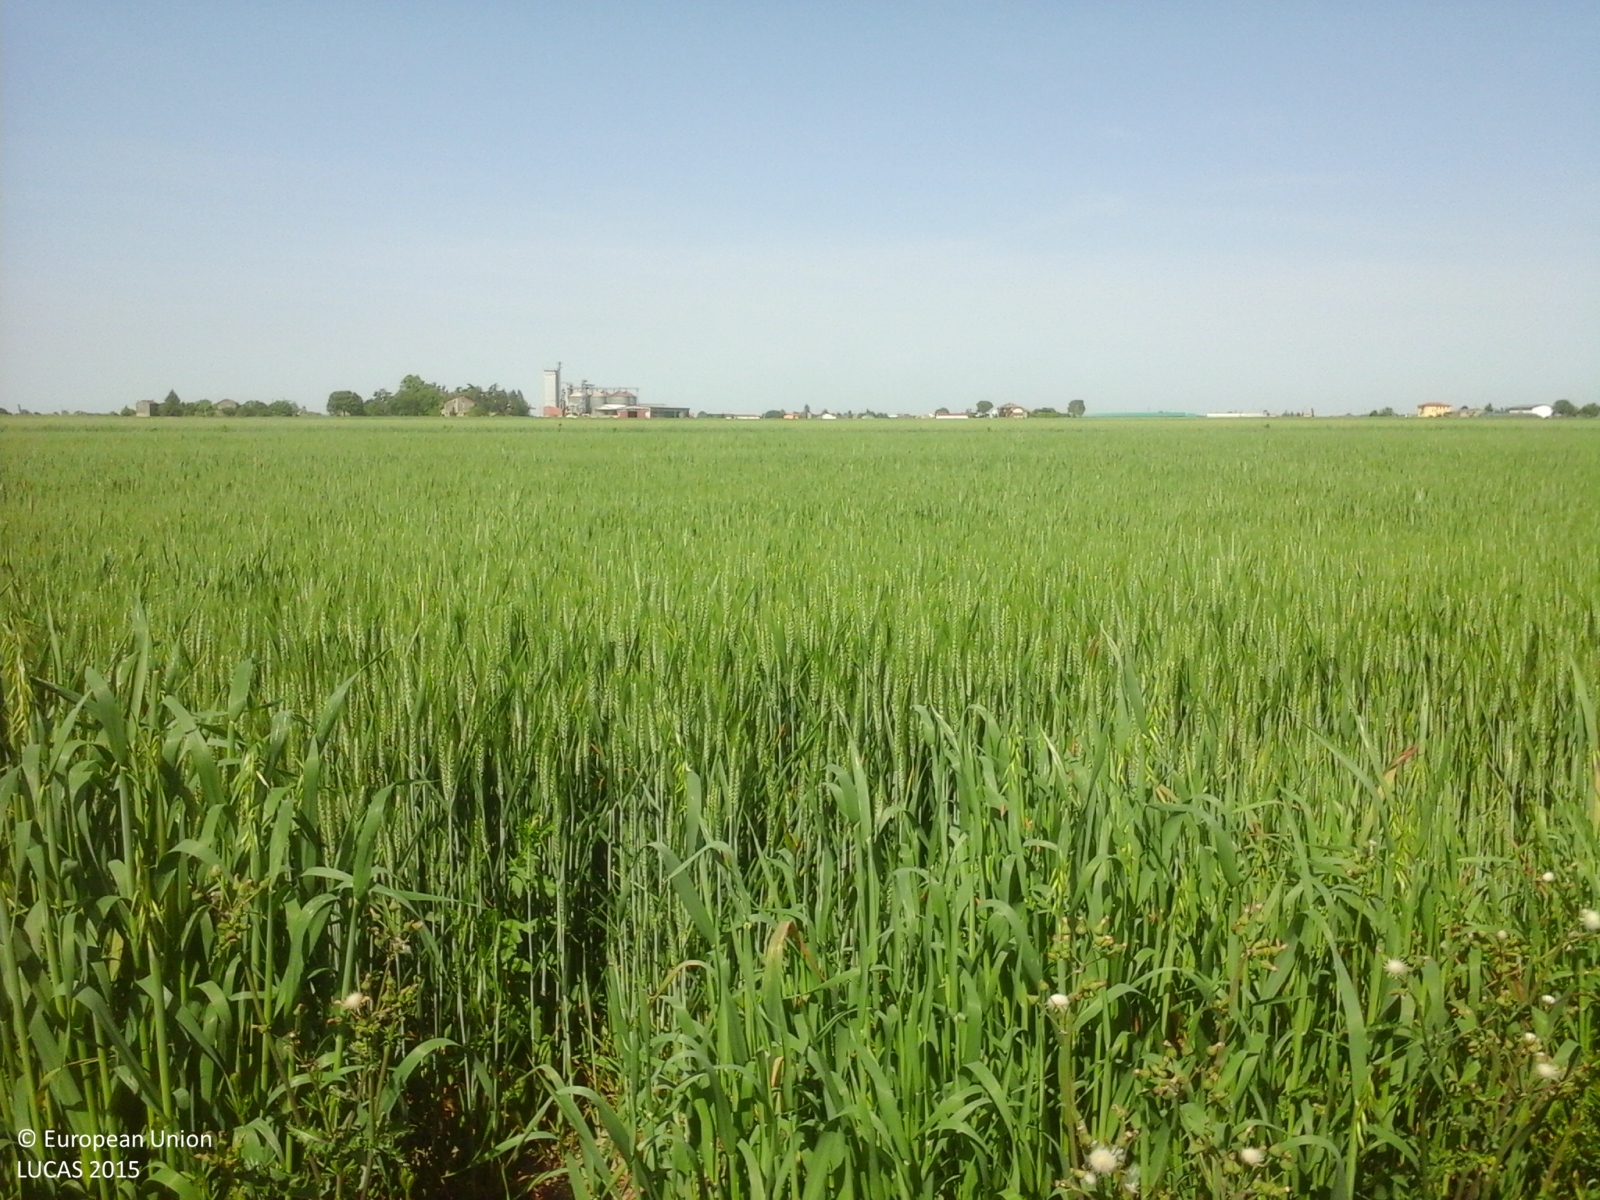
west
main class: Cropland
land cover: Common wheat
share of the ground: > 75 %
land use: Agriculture (excluding fallow land and kitchen gardens)
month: May
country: IT
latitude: 44.9673
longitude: 11.7337
